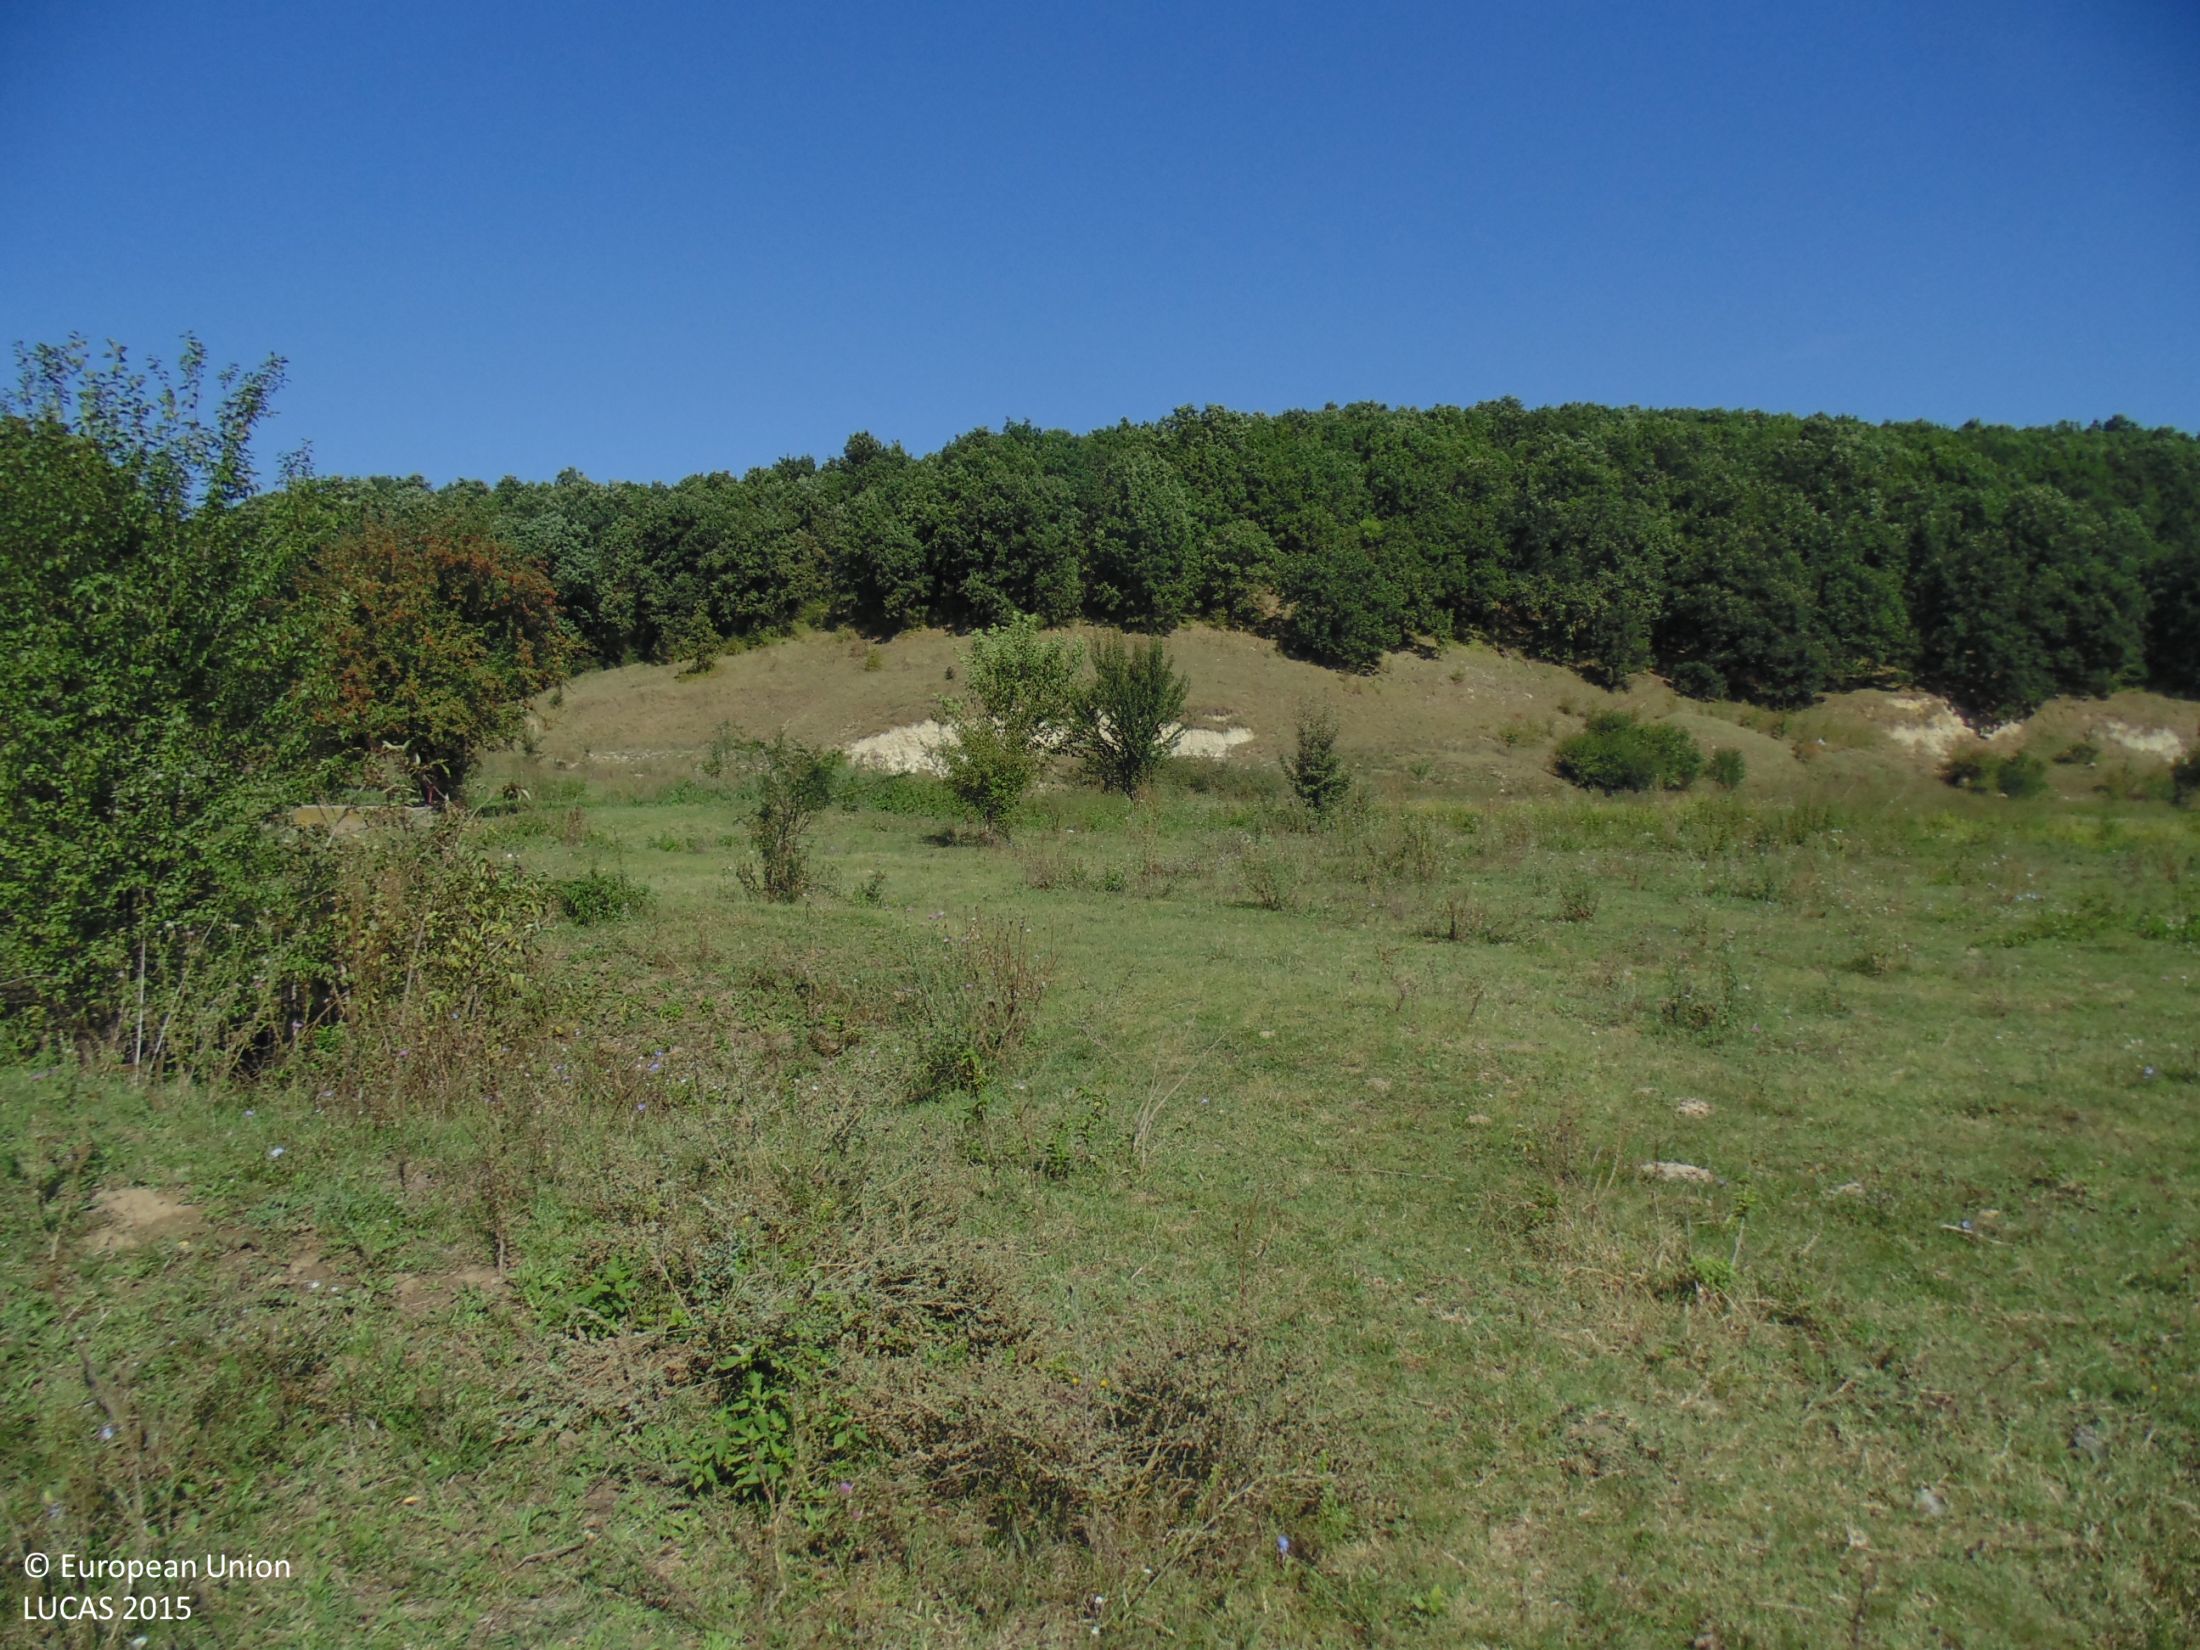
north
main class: Grassland
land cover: Grassland with sparse tree/shrub cover
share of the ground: > 75 %
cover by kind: herbaceous plants 90 %, broadleaved forest trees 5 %, shrubs 5 %
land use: Agriculture (excluding fallow land and kitchen gardens)
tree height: < 5 m
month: September
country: BG
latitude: 44.0514
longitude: 27.0375
